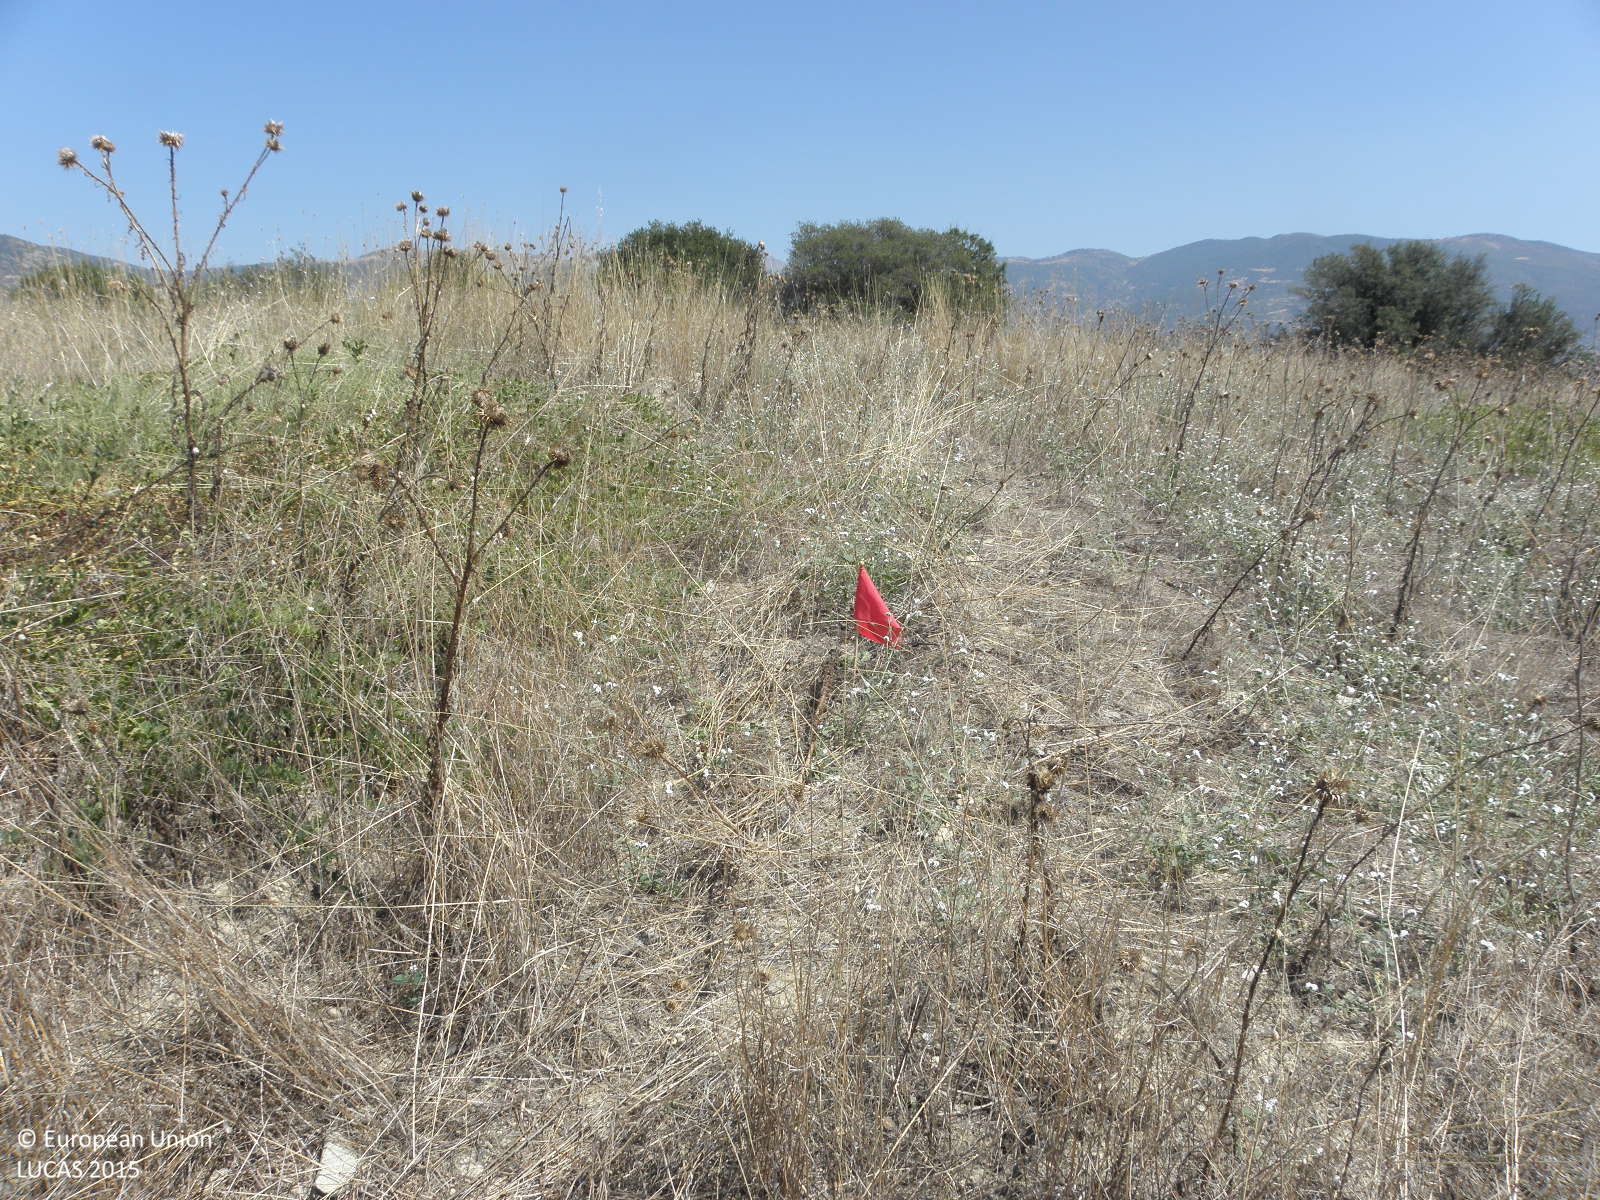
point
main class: Grassland
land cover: Spontaneously vegetated surfaces
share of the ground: > 75 %
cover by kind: herbaceous plants 95 %, shrubs 5 %
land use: Fallow land
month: August
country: GR
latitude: 39.7699
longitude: 22.5423
